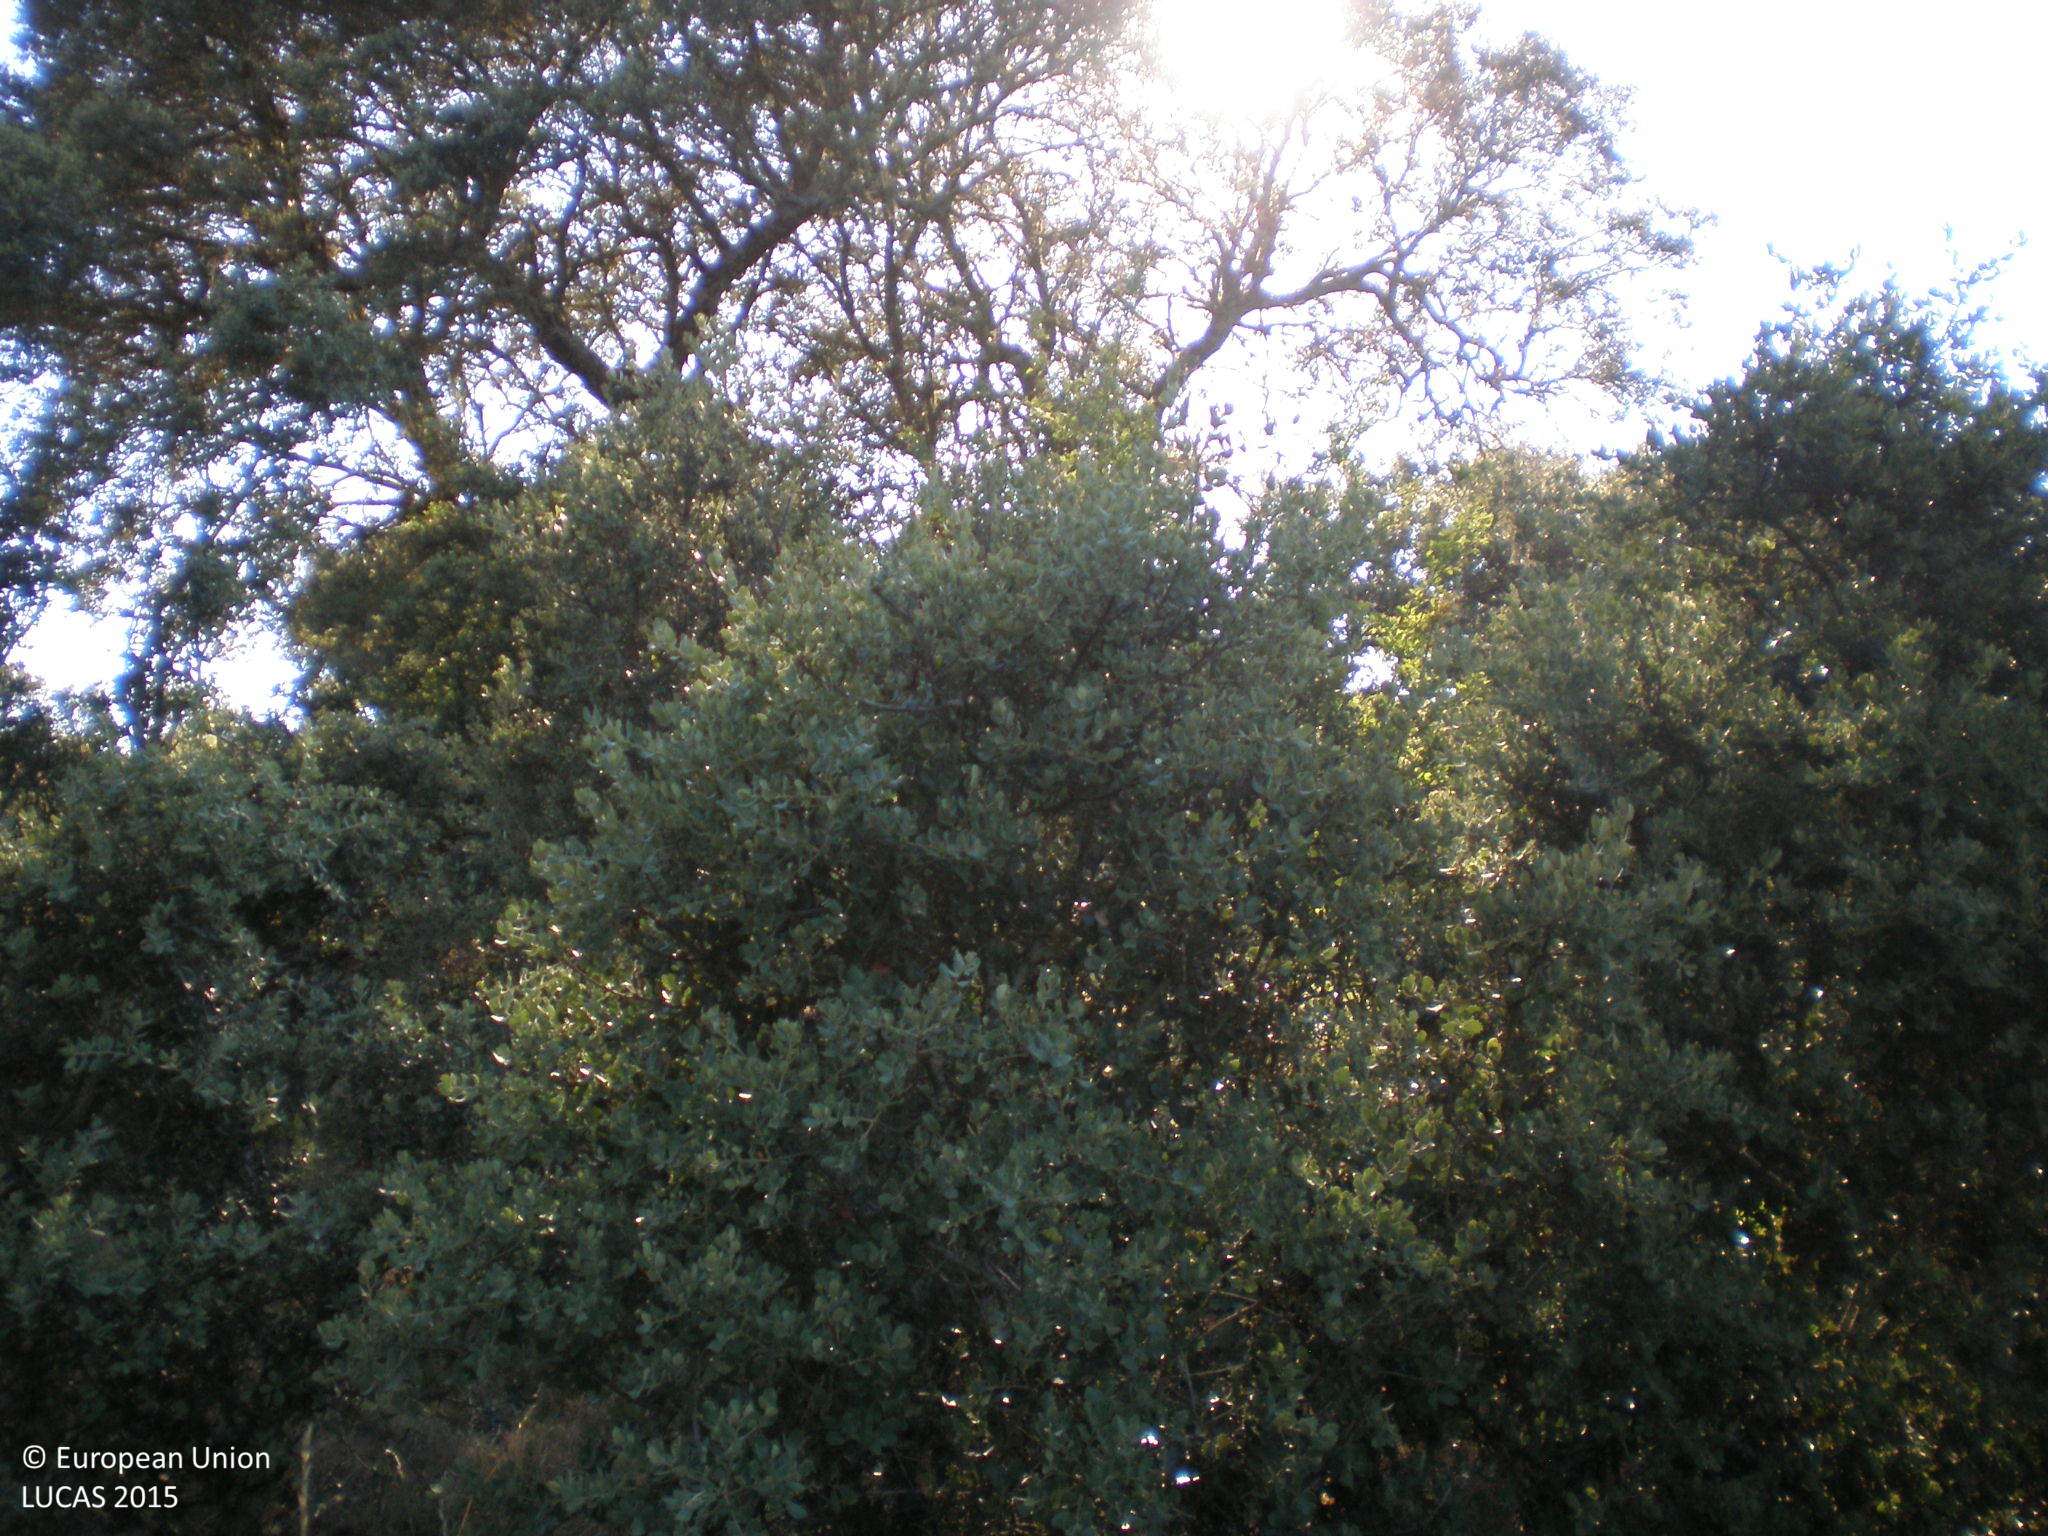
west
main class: Woodland
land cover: Broadleaved woodland
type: broadleaved evergreen forest
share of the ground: 50 - 75 %
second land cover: Grassland without tree/shrub cover
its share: 25 - 50 %
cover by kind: broadleaved forest trees 55 %, herbaceous plants 45 %
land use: Forestry
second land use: Agriculture (excluding fallow land and kitchen gardens)
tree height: > 5 m
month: June
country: ES
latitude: 40.7456
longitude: -5.6715
